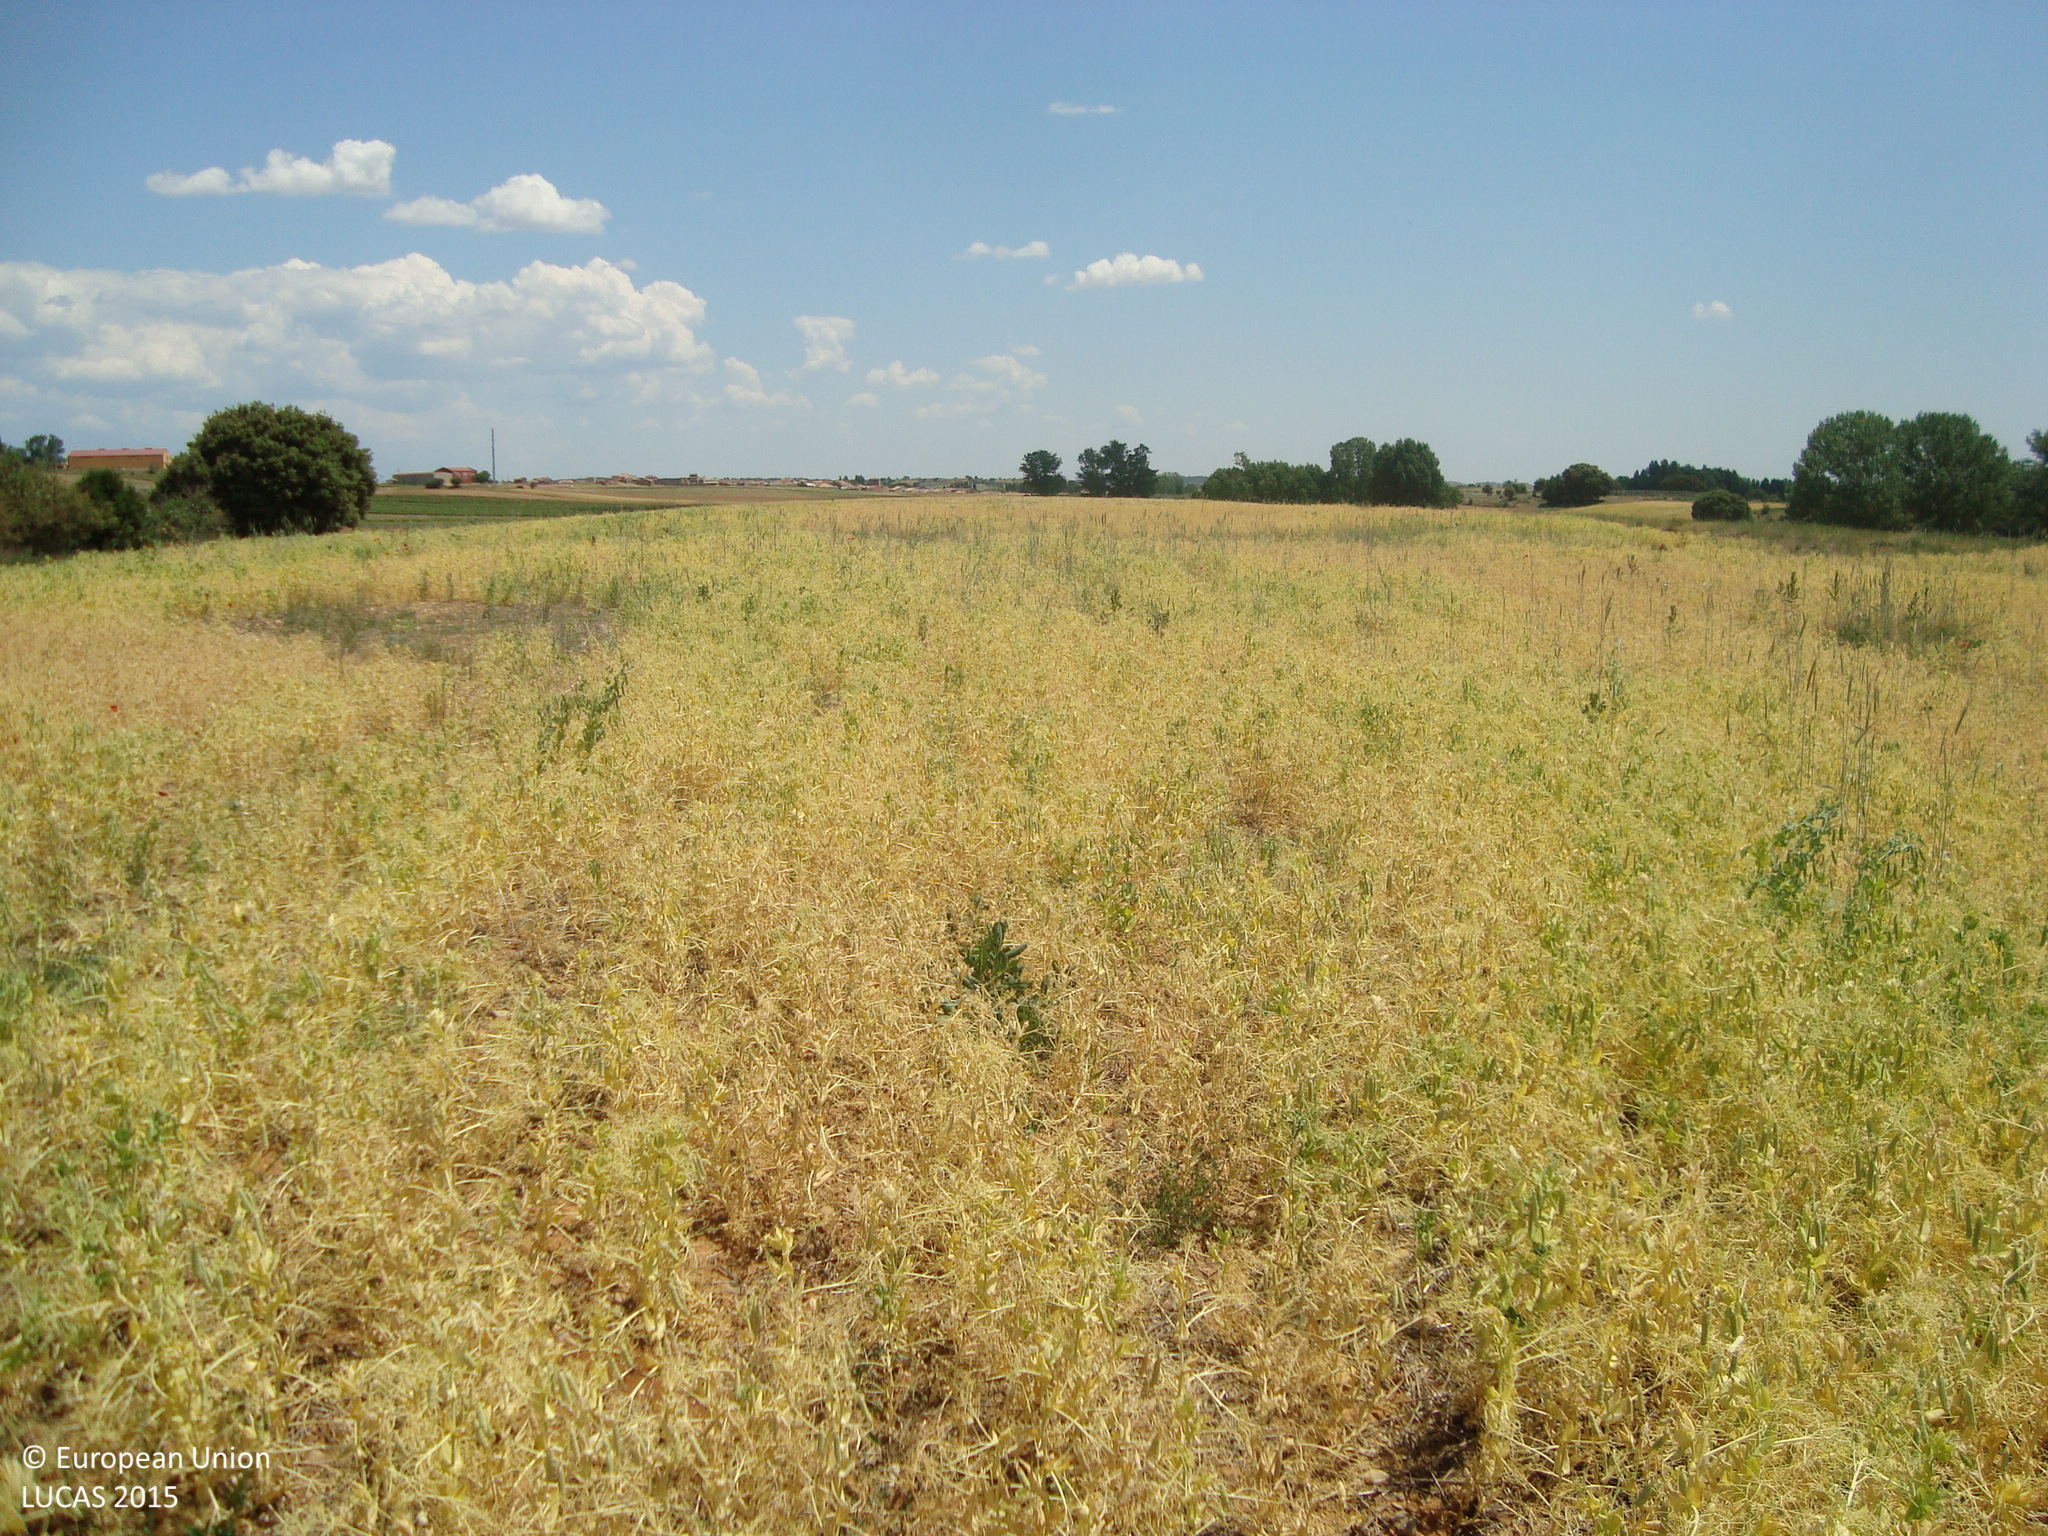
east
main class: Cropland
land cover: Dry pulses
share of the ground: > 75 %
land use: Agriculture (excluding fallow land and kitchen gardens)
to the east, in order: Dry pulses; Barley; Spontaneously vegetated surfaces; Barley
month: June
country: ES
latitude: 41.6962
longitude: -3.5935
